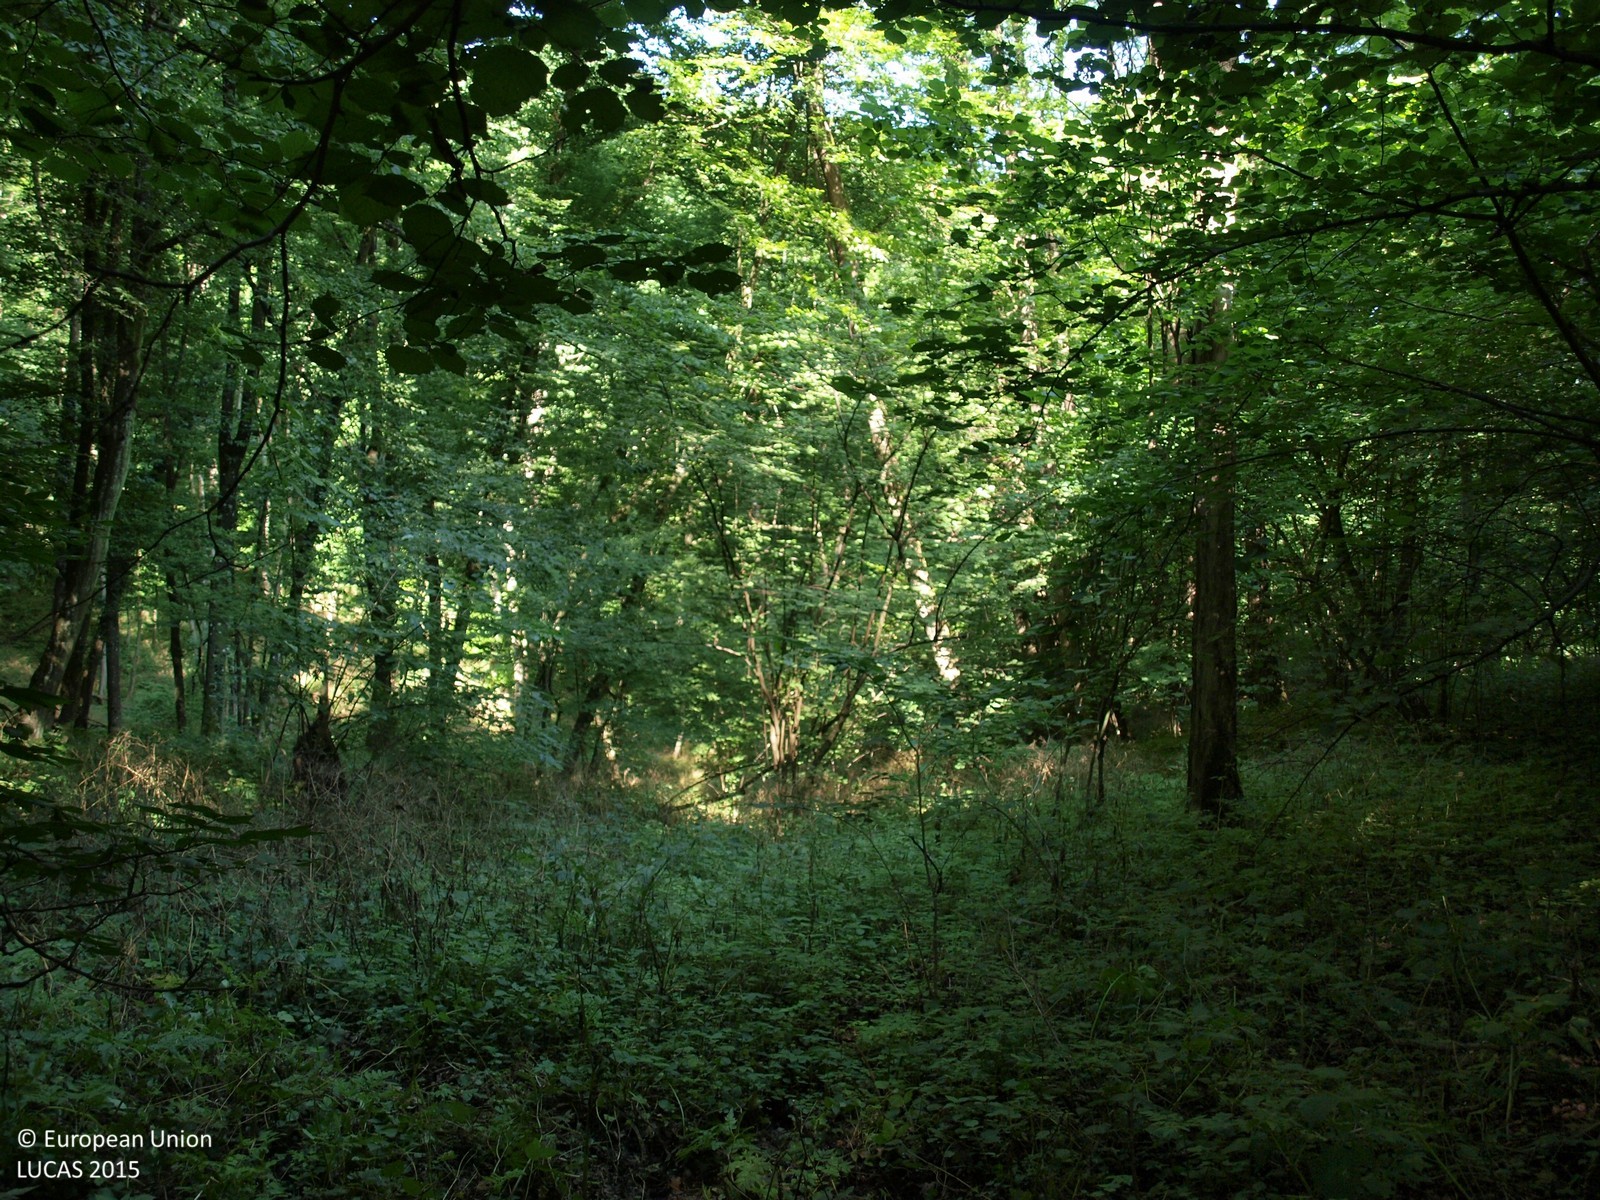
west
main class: Woodland
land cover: Broadleaved woodland
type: mesophytic deciduous forest
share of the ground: > 75 %
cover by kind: broadleaved forest trees 100 %
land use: Forestry
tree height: > 5 m
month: July
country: HR
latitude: 45.9869
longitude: 15.9495
